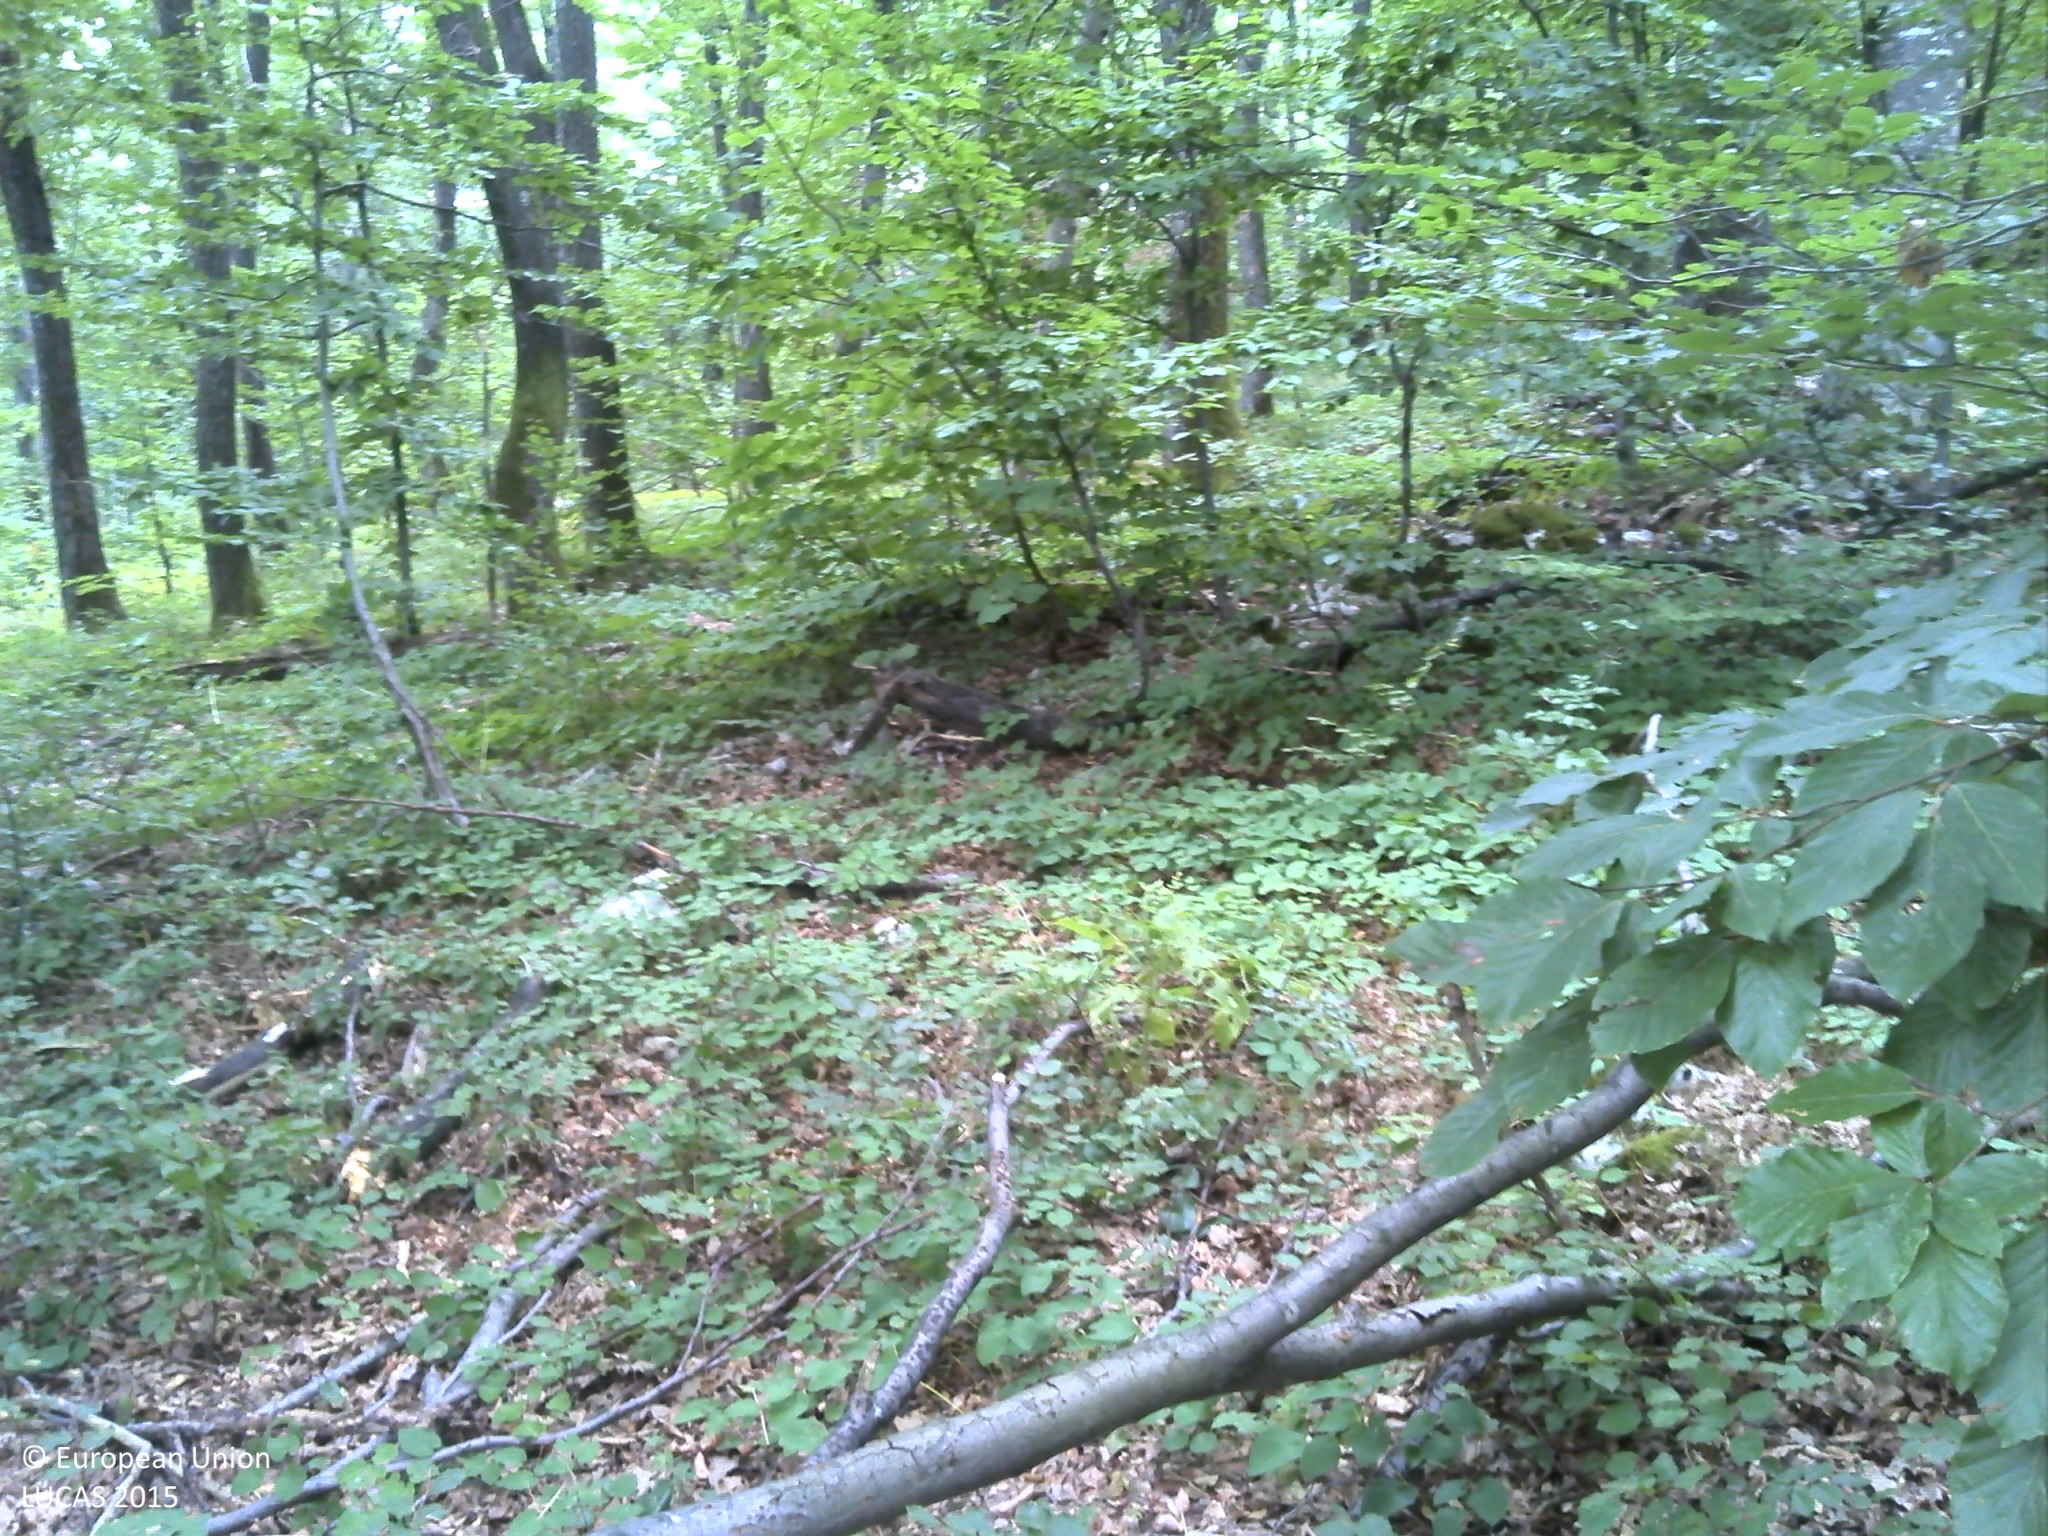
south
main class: Woodland
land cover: Broadleaved woodland
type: beech forest
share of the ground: > 75 %
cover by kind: broadleaved forest trees 100 %
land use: Forestry
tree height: > 5 m
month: September
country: HR
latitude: 45.3574
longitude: 15.2166
